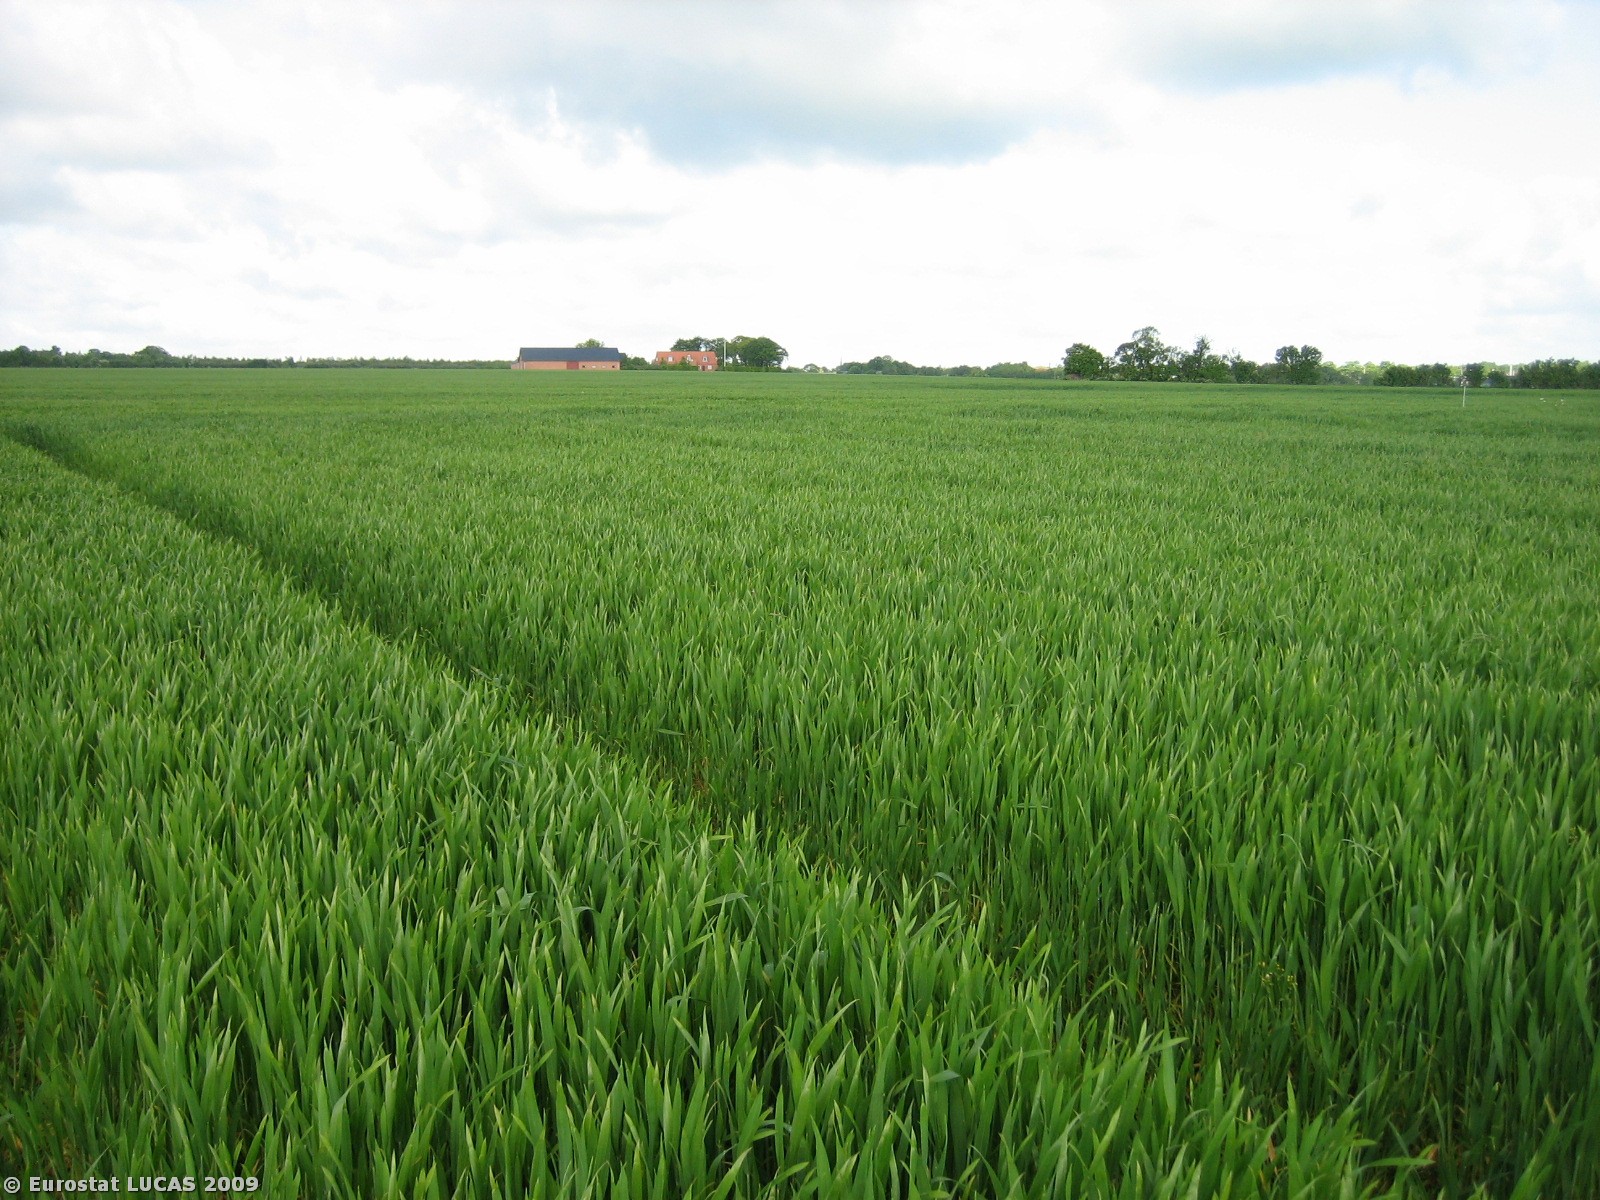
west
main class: Cropland
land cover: Barley
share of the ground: > 75 %
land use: Agriculture (excluding fallow land and kitchen gardens)
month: May
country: DK
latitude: 56.1293
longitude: 8.9233
